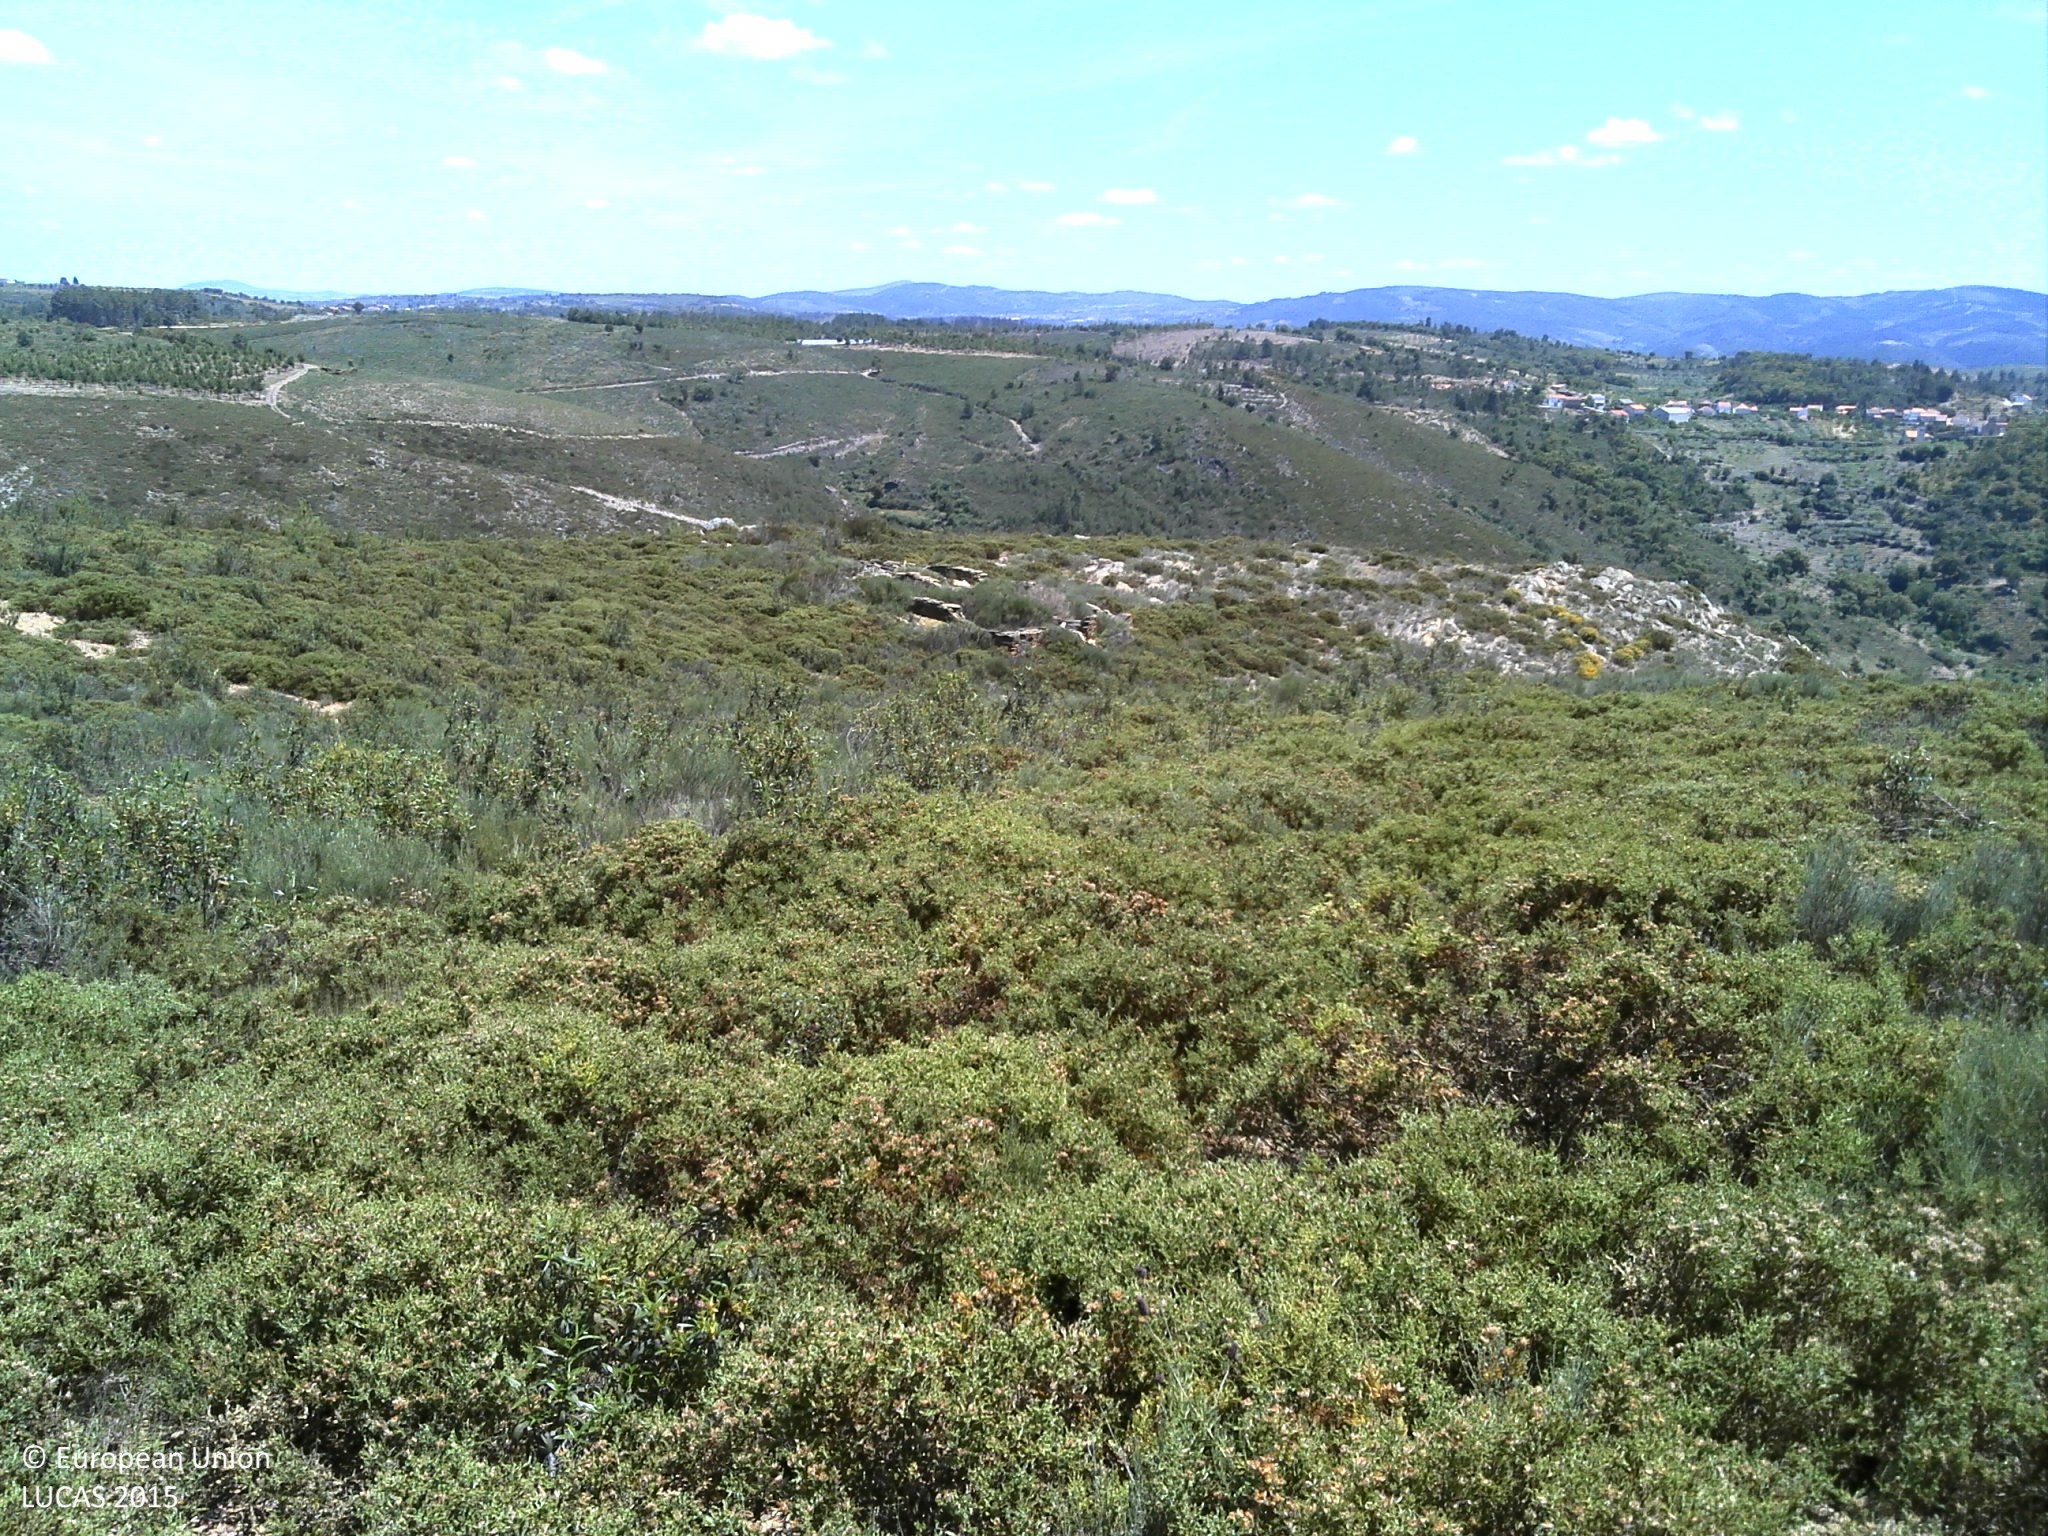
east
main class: Shrubland
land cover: Shrubland without tree cover
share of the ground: > 75 %
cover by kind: shrubs 80 %, unconsolidated bare surface 20 %
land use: Abandoned areas
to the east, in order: Shrubland without tree cover; Rock outcrops; Shrubland without tree cover
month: May
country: PT
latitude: 41.1624
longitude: -6.9236
